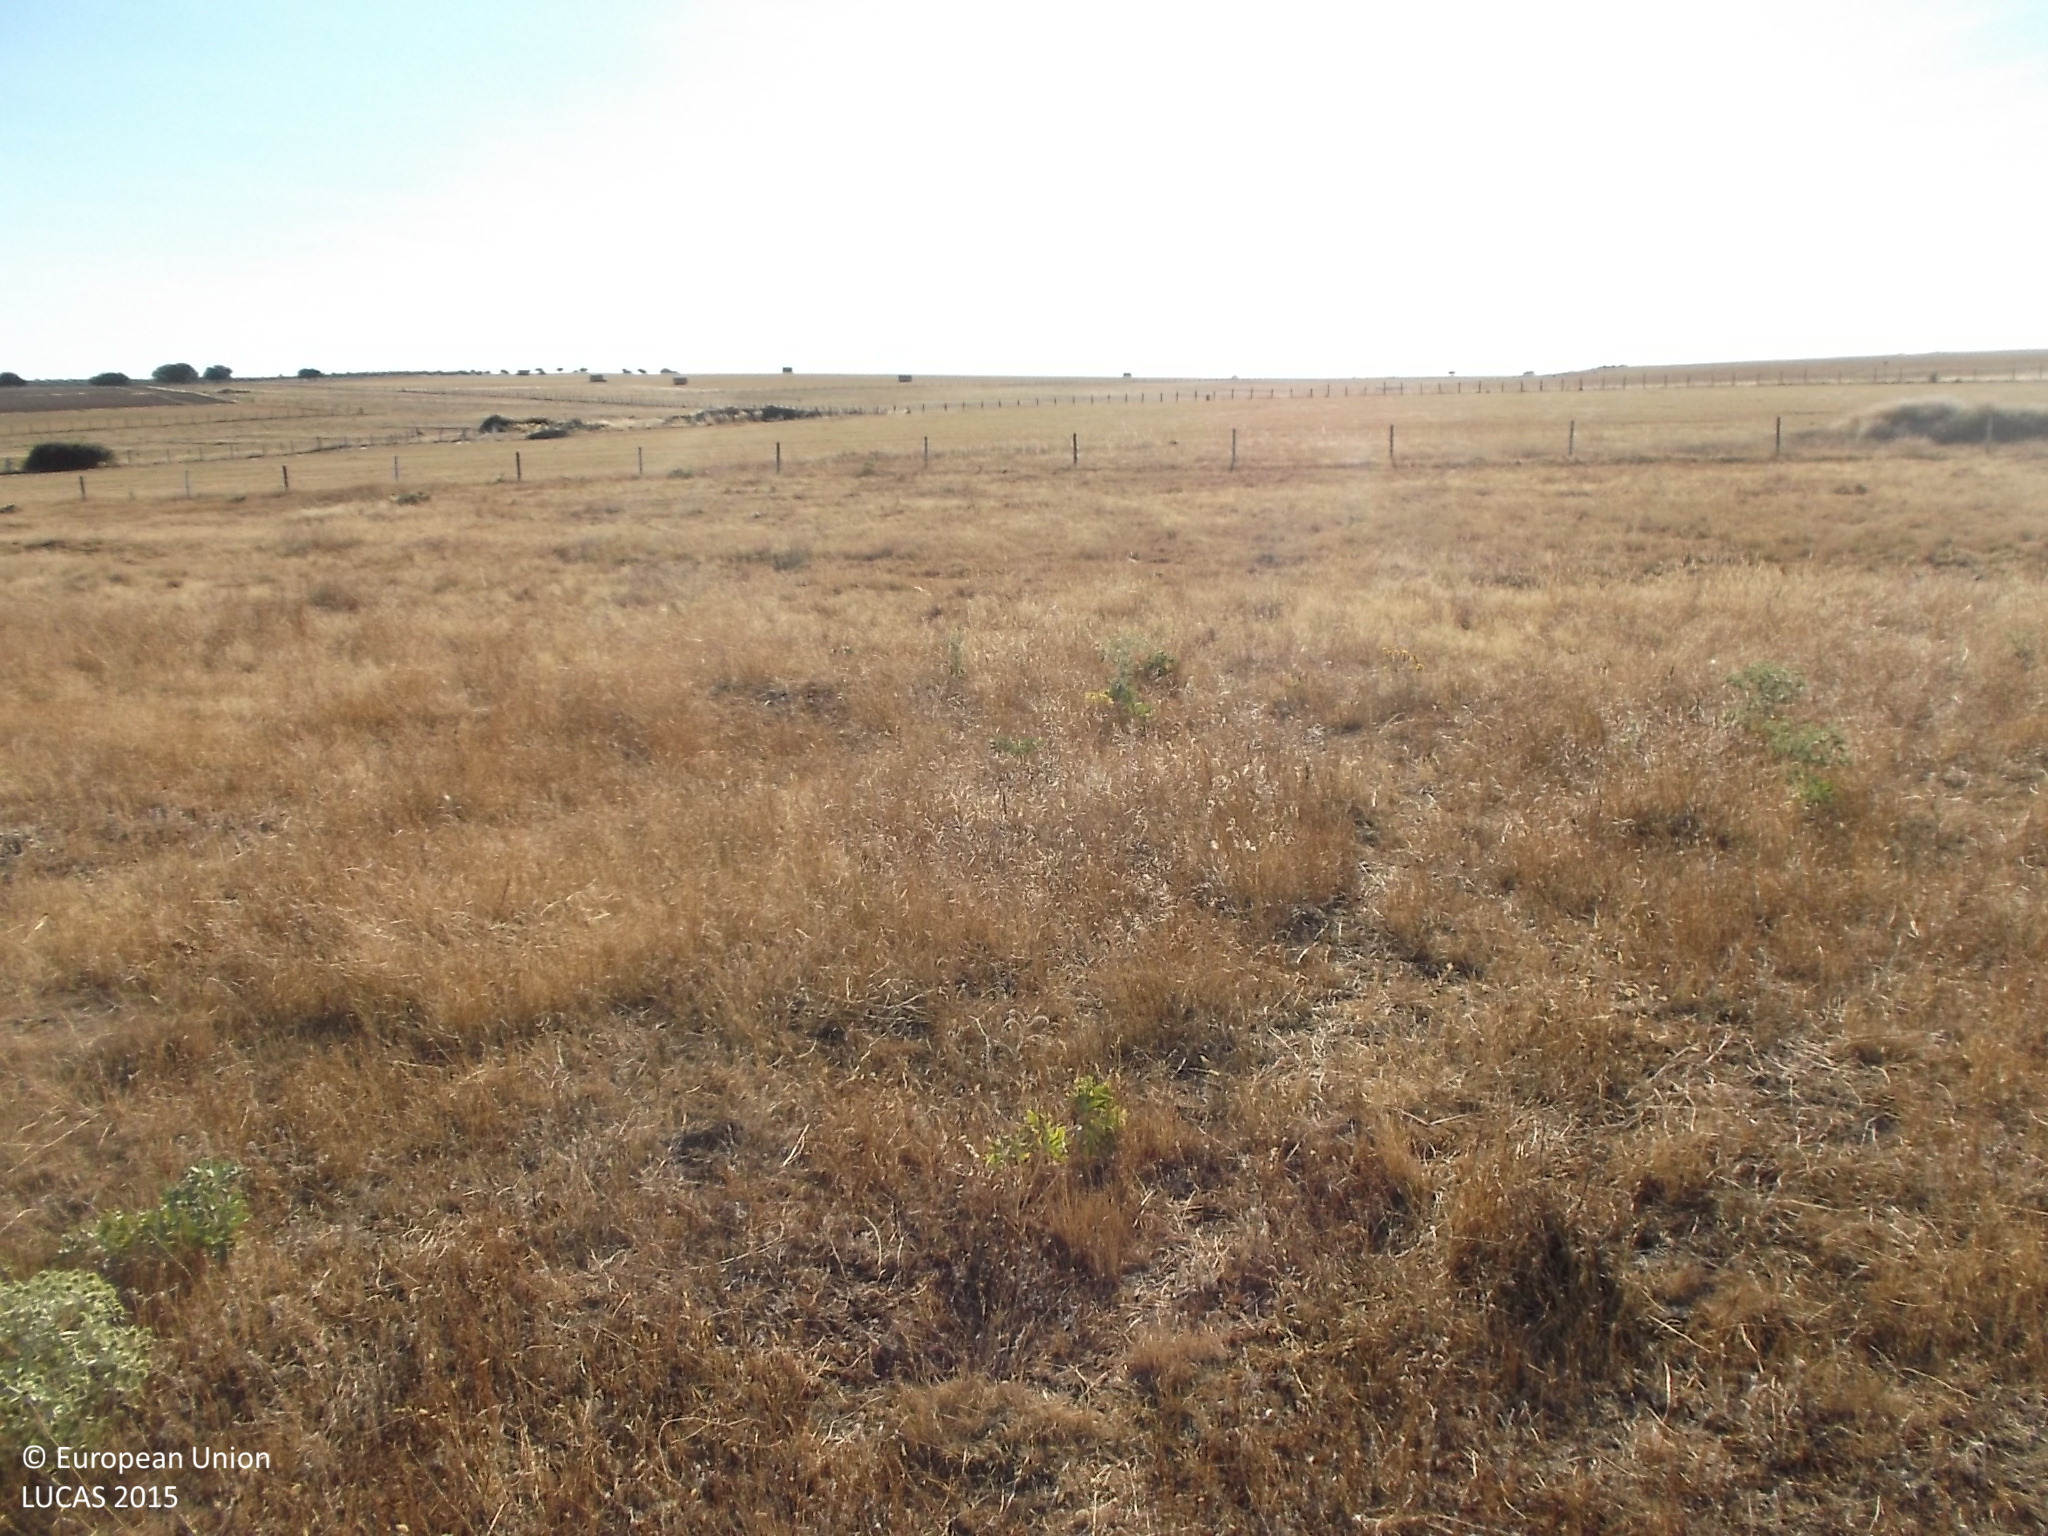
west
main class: Grassland
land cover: Grassland without tree/shrub cover
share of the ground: > 75 %
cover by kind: herbaceous plants 100 %
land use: Agriculture (excluding fallow land and kitchen gardens)
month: July
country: ES
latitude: 41.1428
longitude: -5.9433
